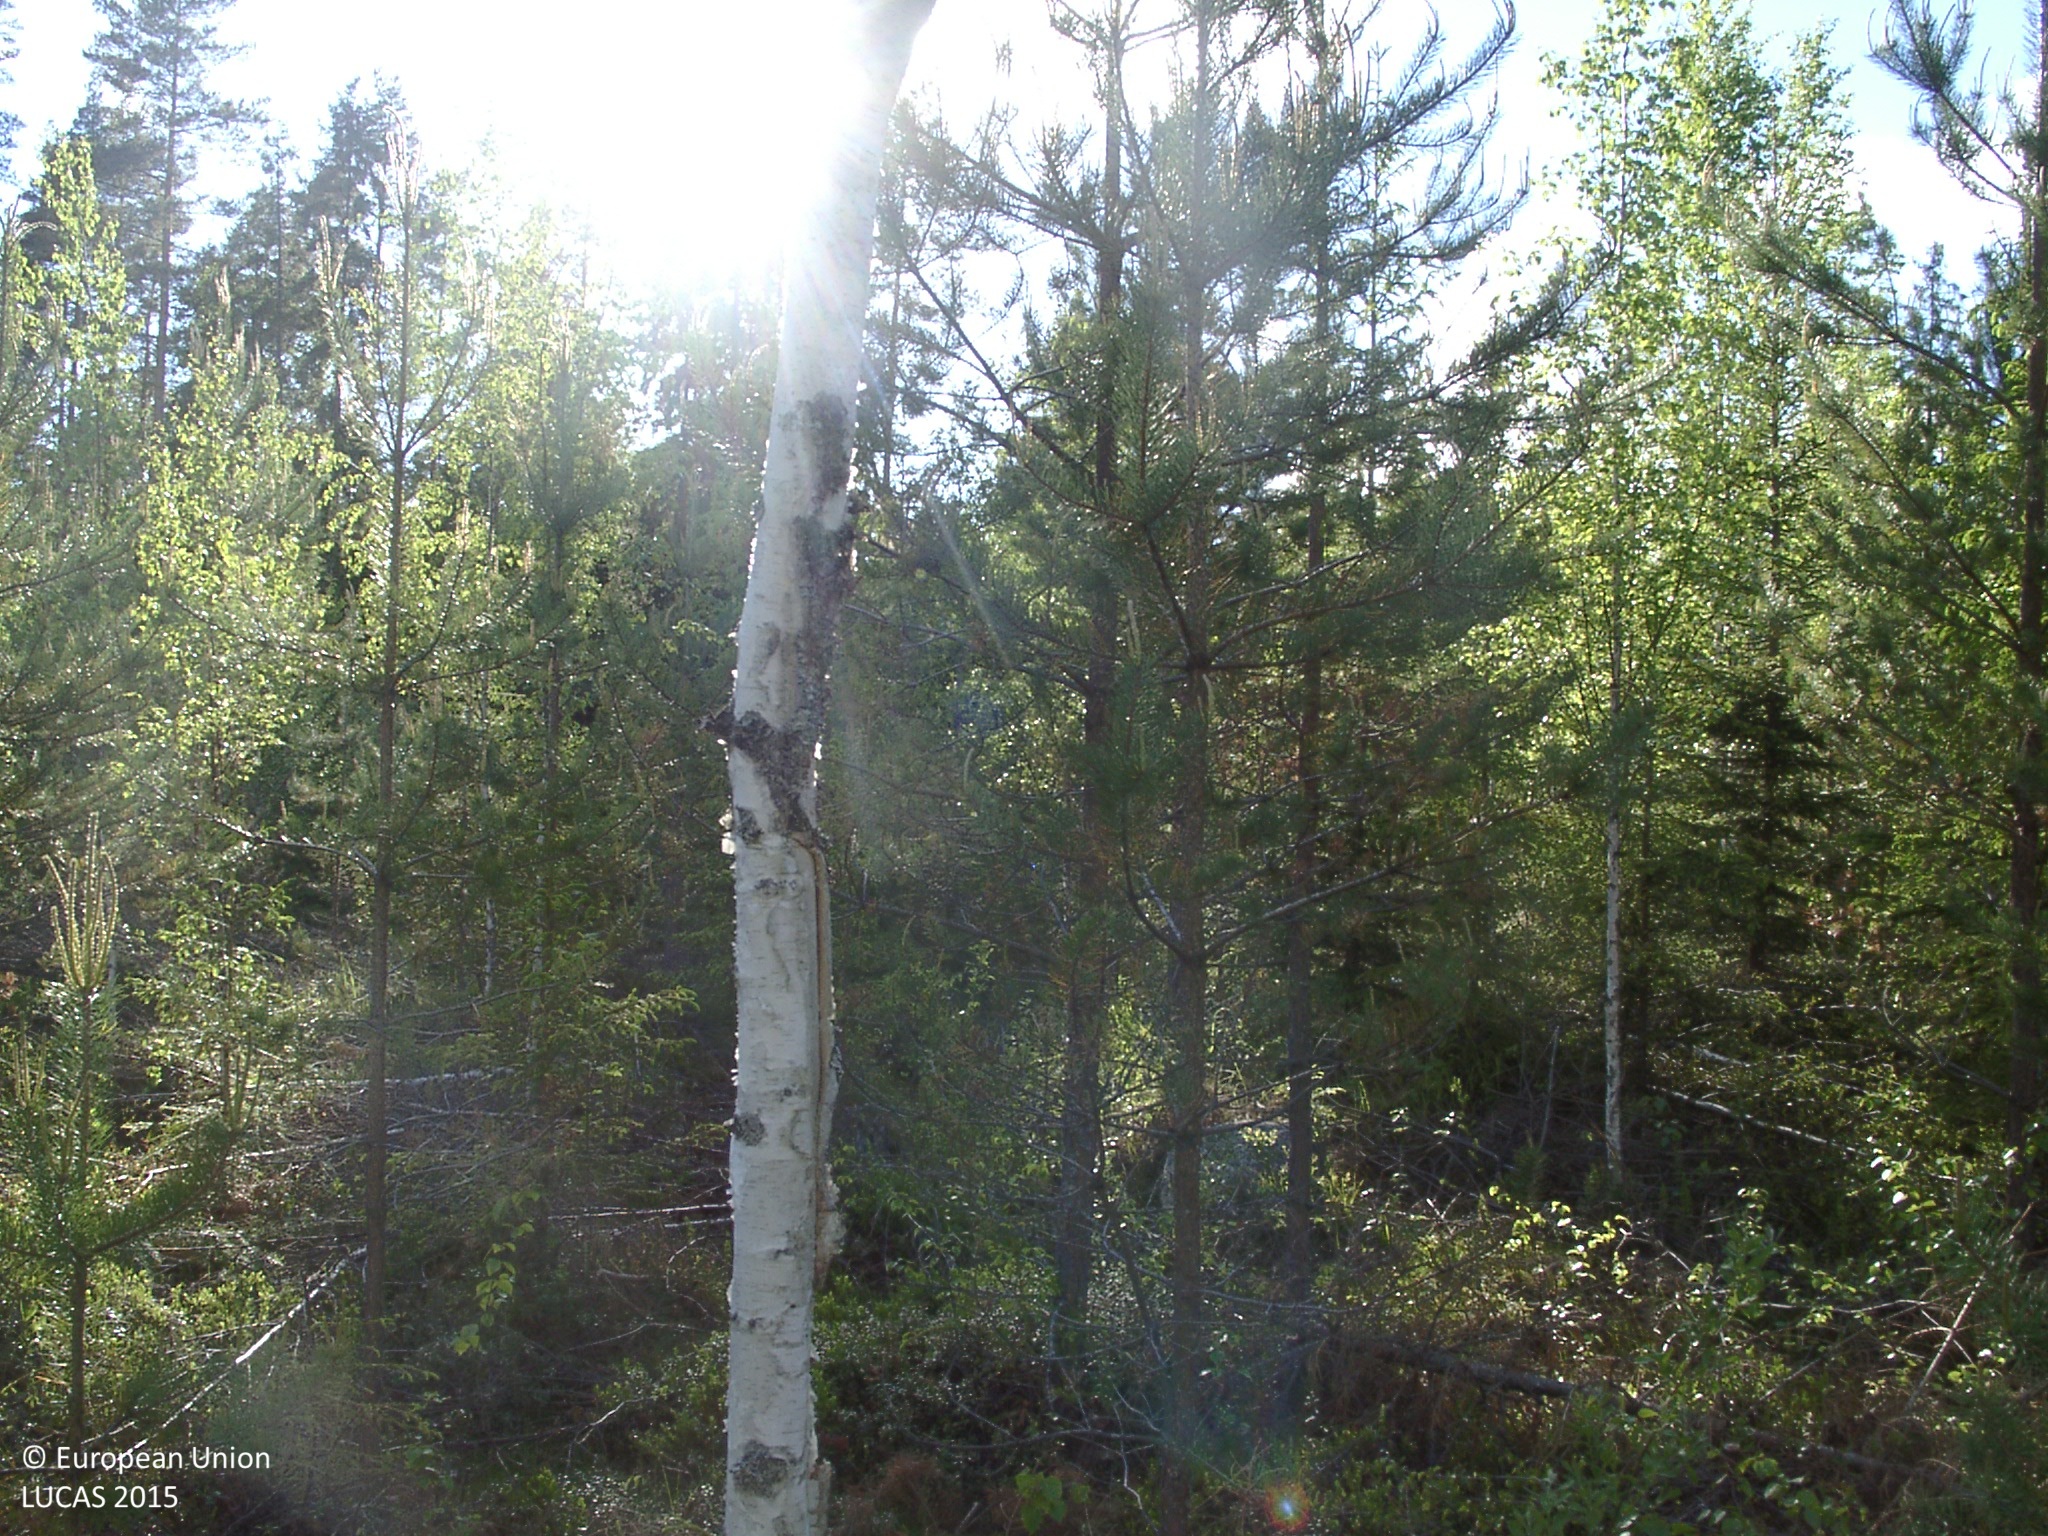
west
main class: Woodland
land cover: Other mixed woodland
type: boreal forest
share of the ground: 25 - 50 %
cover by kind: coniferous forest trees 30 %, shrubs 25 %, broadleaved forest trees 10 %, lichens and mosses 10 %, herbaceous plants 5 %
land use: Forestry
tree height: < 5 m
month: June
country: FI
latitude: 61.7371
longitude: 24.8899
